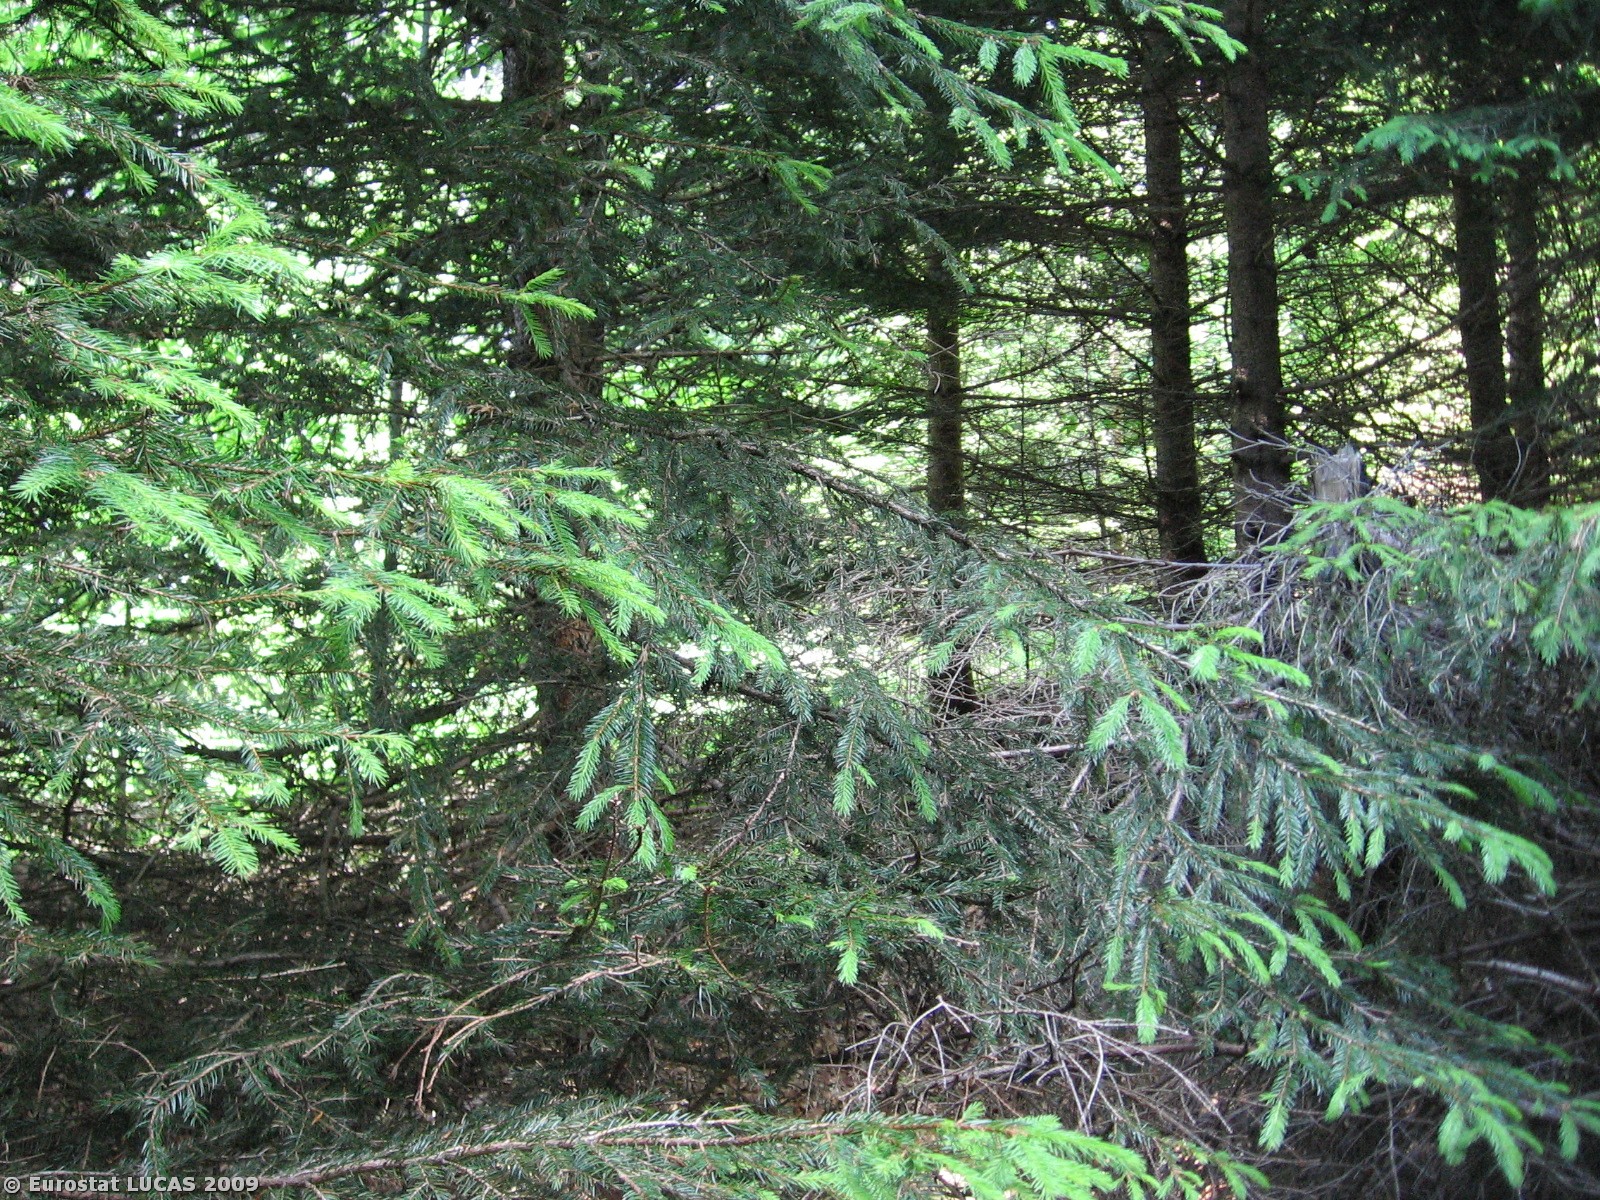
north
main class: Woodland
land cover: Coniferous woodland
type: hemiboreal forest and nemoral coniferous forest and mixed broadleaved-coniferous forest
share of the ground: > 75 %
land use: Forestry
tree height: > 5 m
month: June
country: CZ
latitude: 48.9673
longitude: 13.8386
